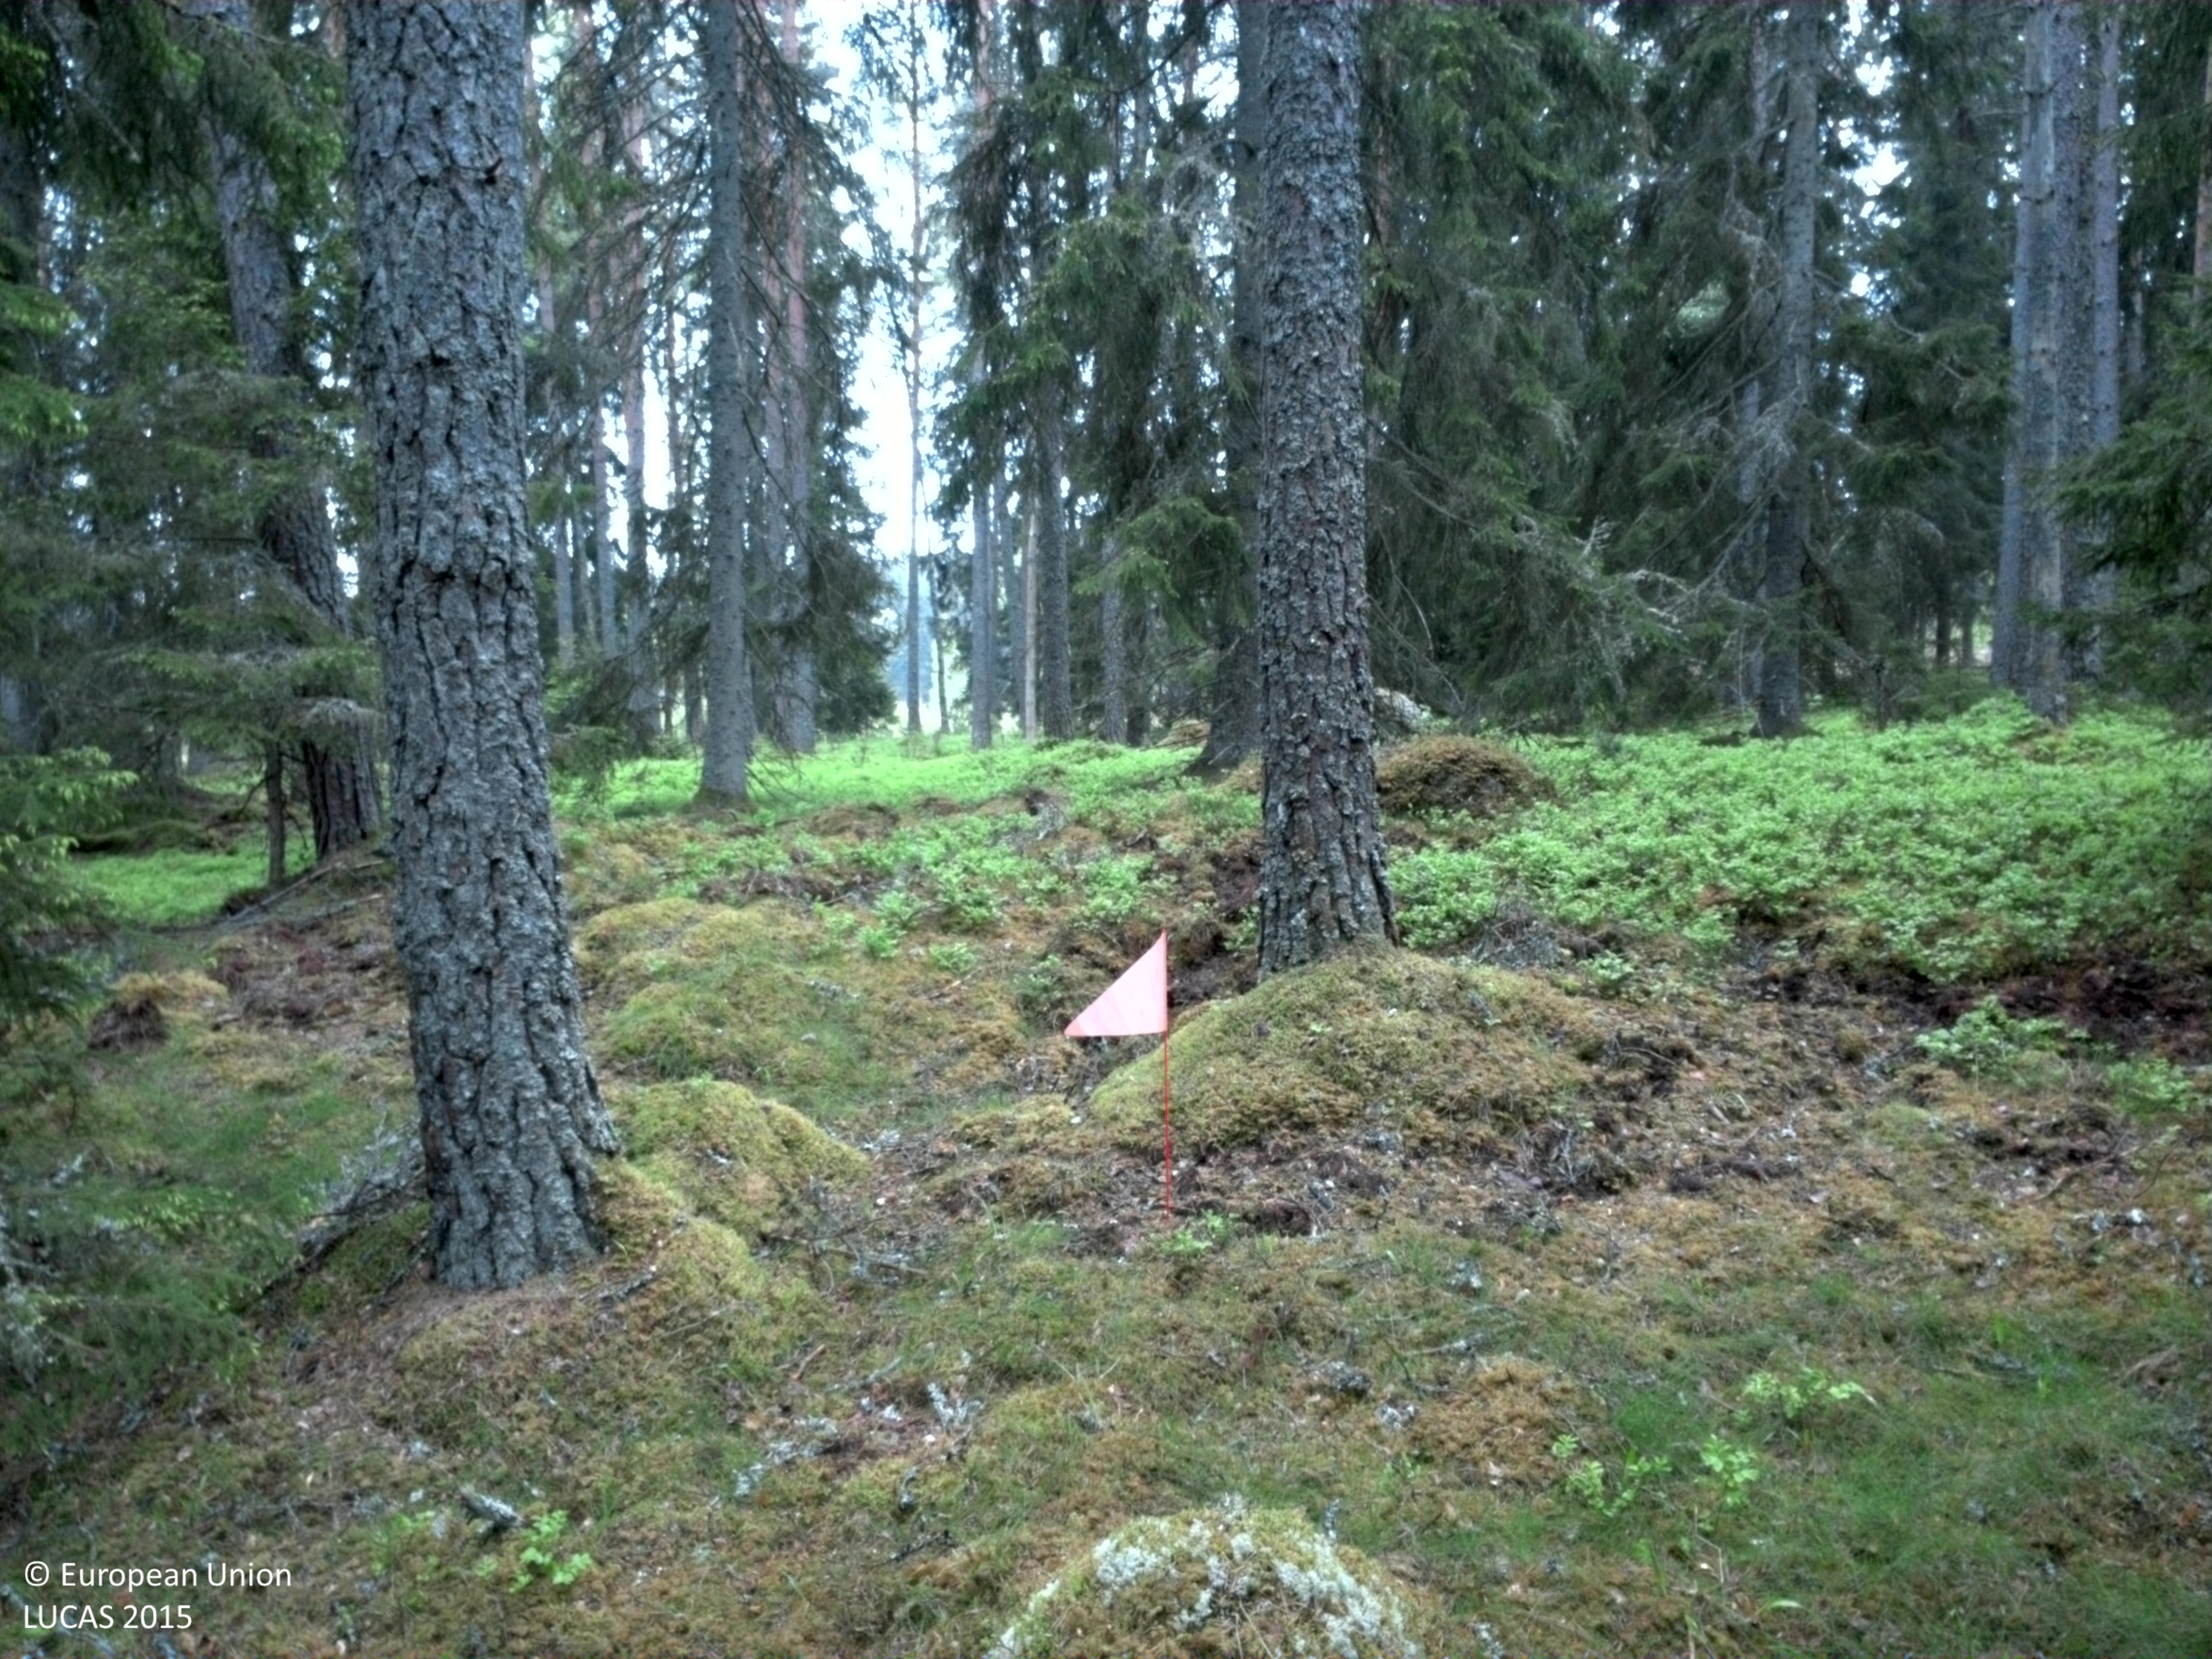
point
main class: Woodland
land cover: Pine dominated coniferous woodland
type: boreal forest
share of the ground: 50 - 75 %
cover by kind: coniferous forest trees 50 %, shrubs 25 %, lichens and mosses 25 %
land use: Forestry
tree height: > 5 m
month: May
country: SE
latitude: 57.4462
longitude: 15.3454
